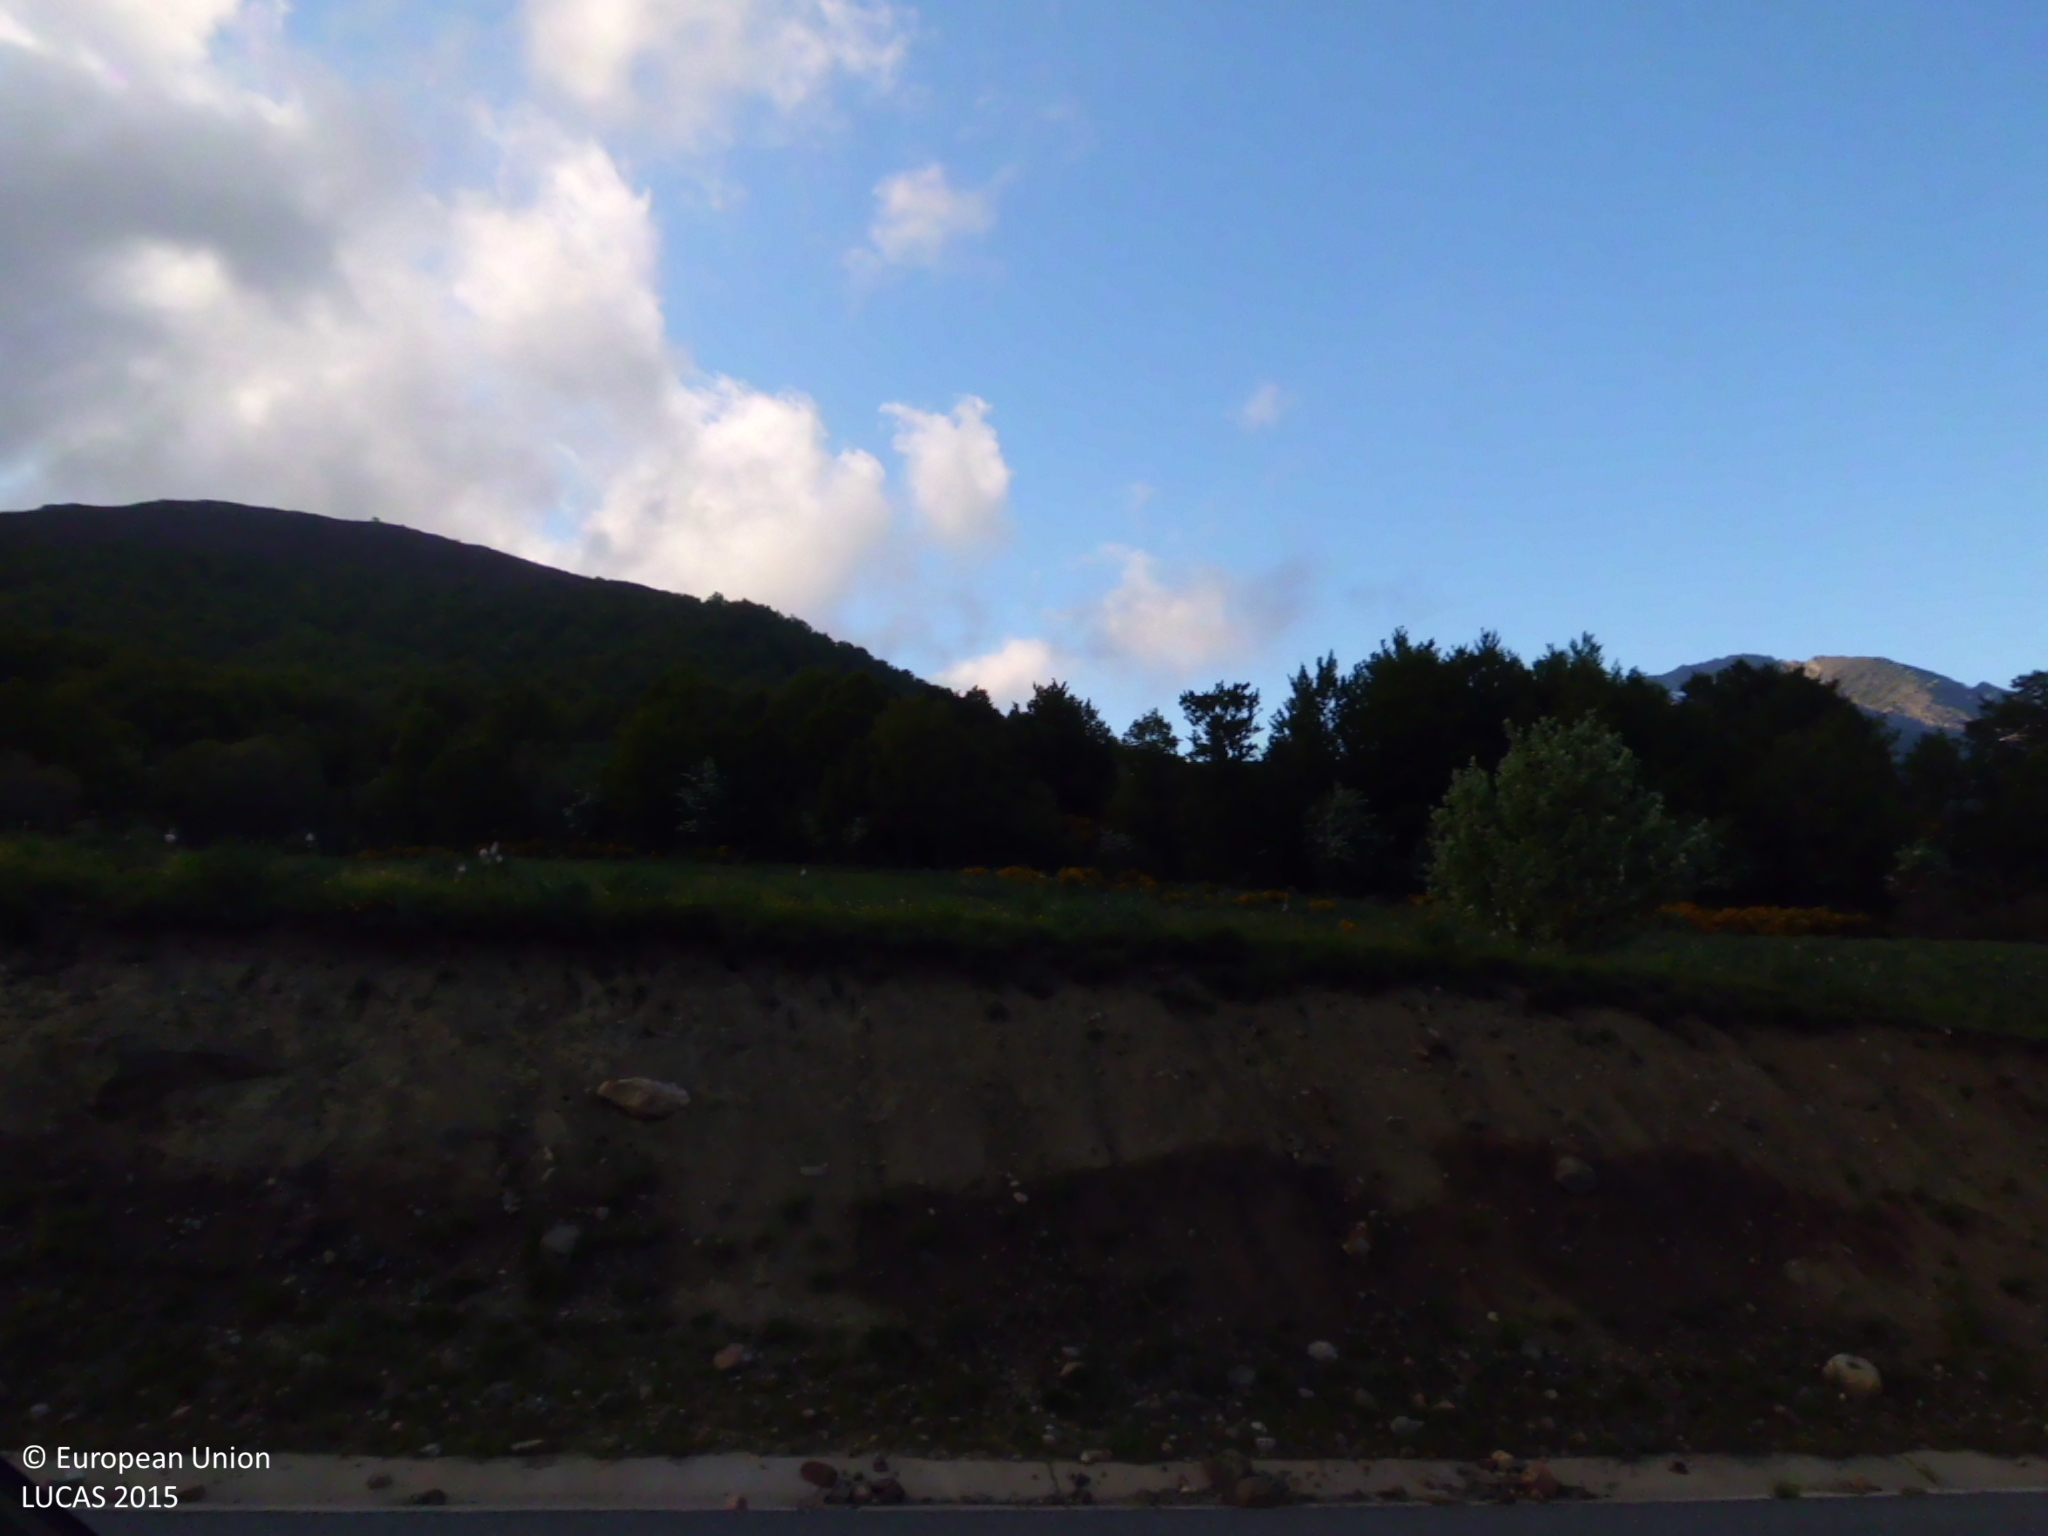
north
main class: Woodland
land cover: Broadleaved woodland
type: acidophilous oak and oak-birch forest
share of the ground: > 75 %
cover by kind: broadleaved forest trees 100 %
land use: Semi-natural and natural areas not in use
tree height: > 5 m
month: May
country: ES
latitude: 43.0639
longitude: -5.1612
